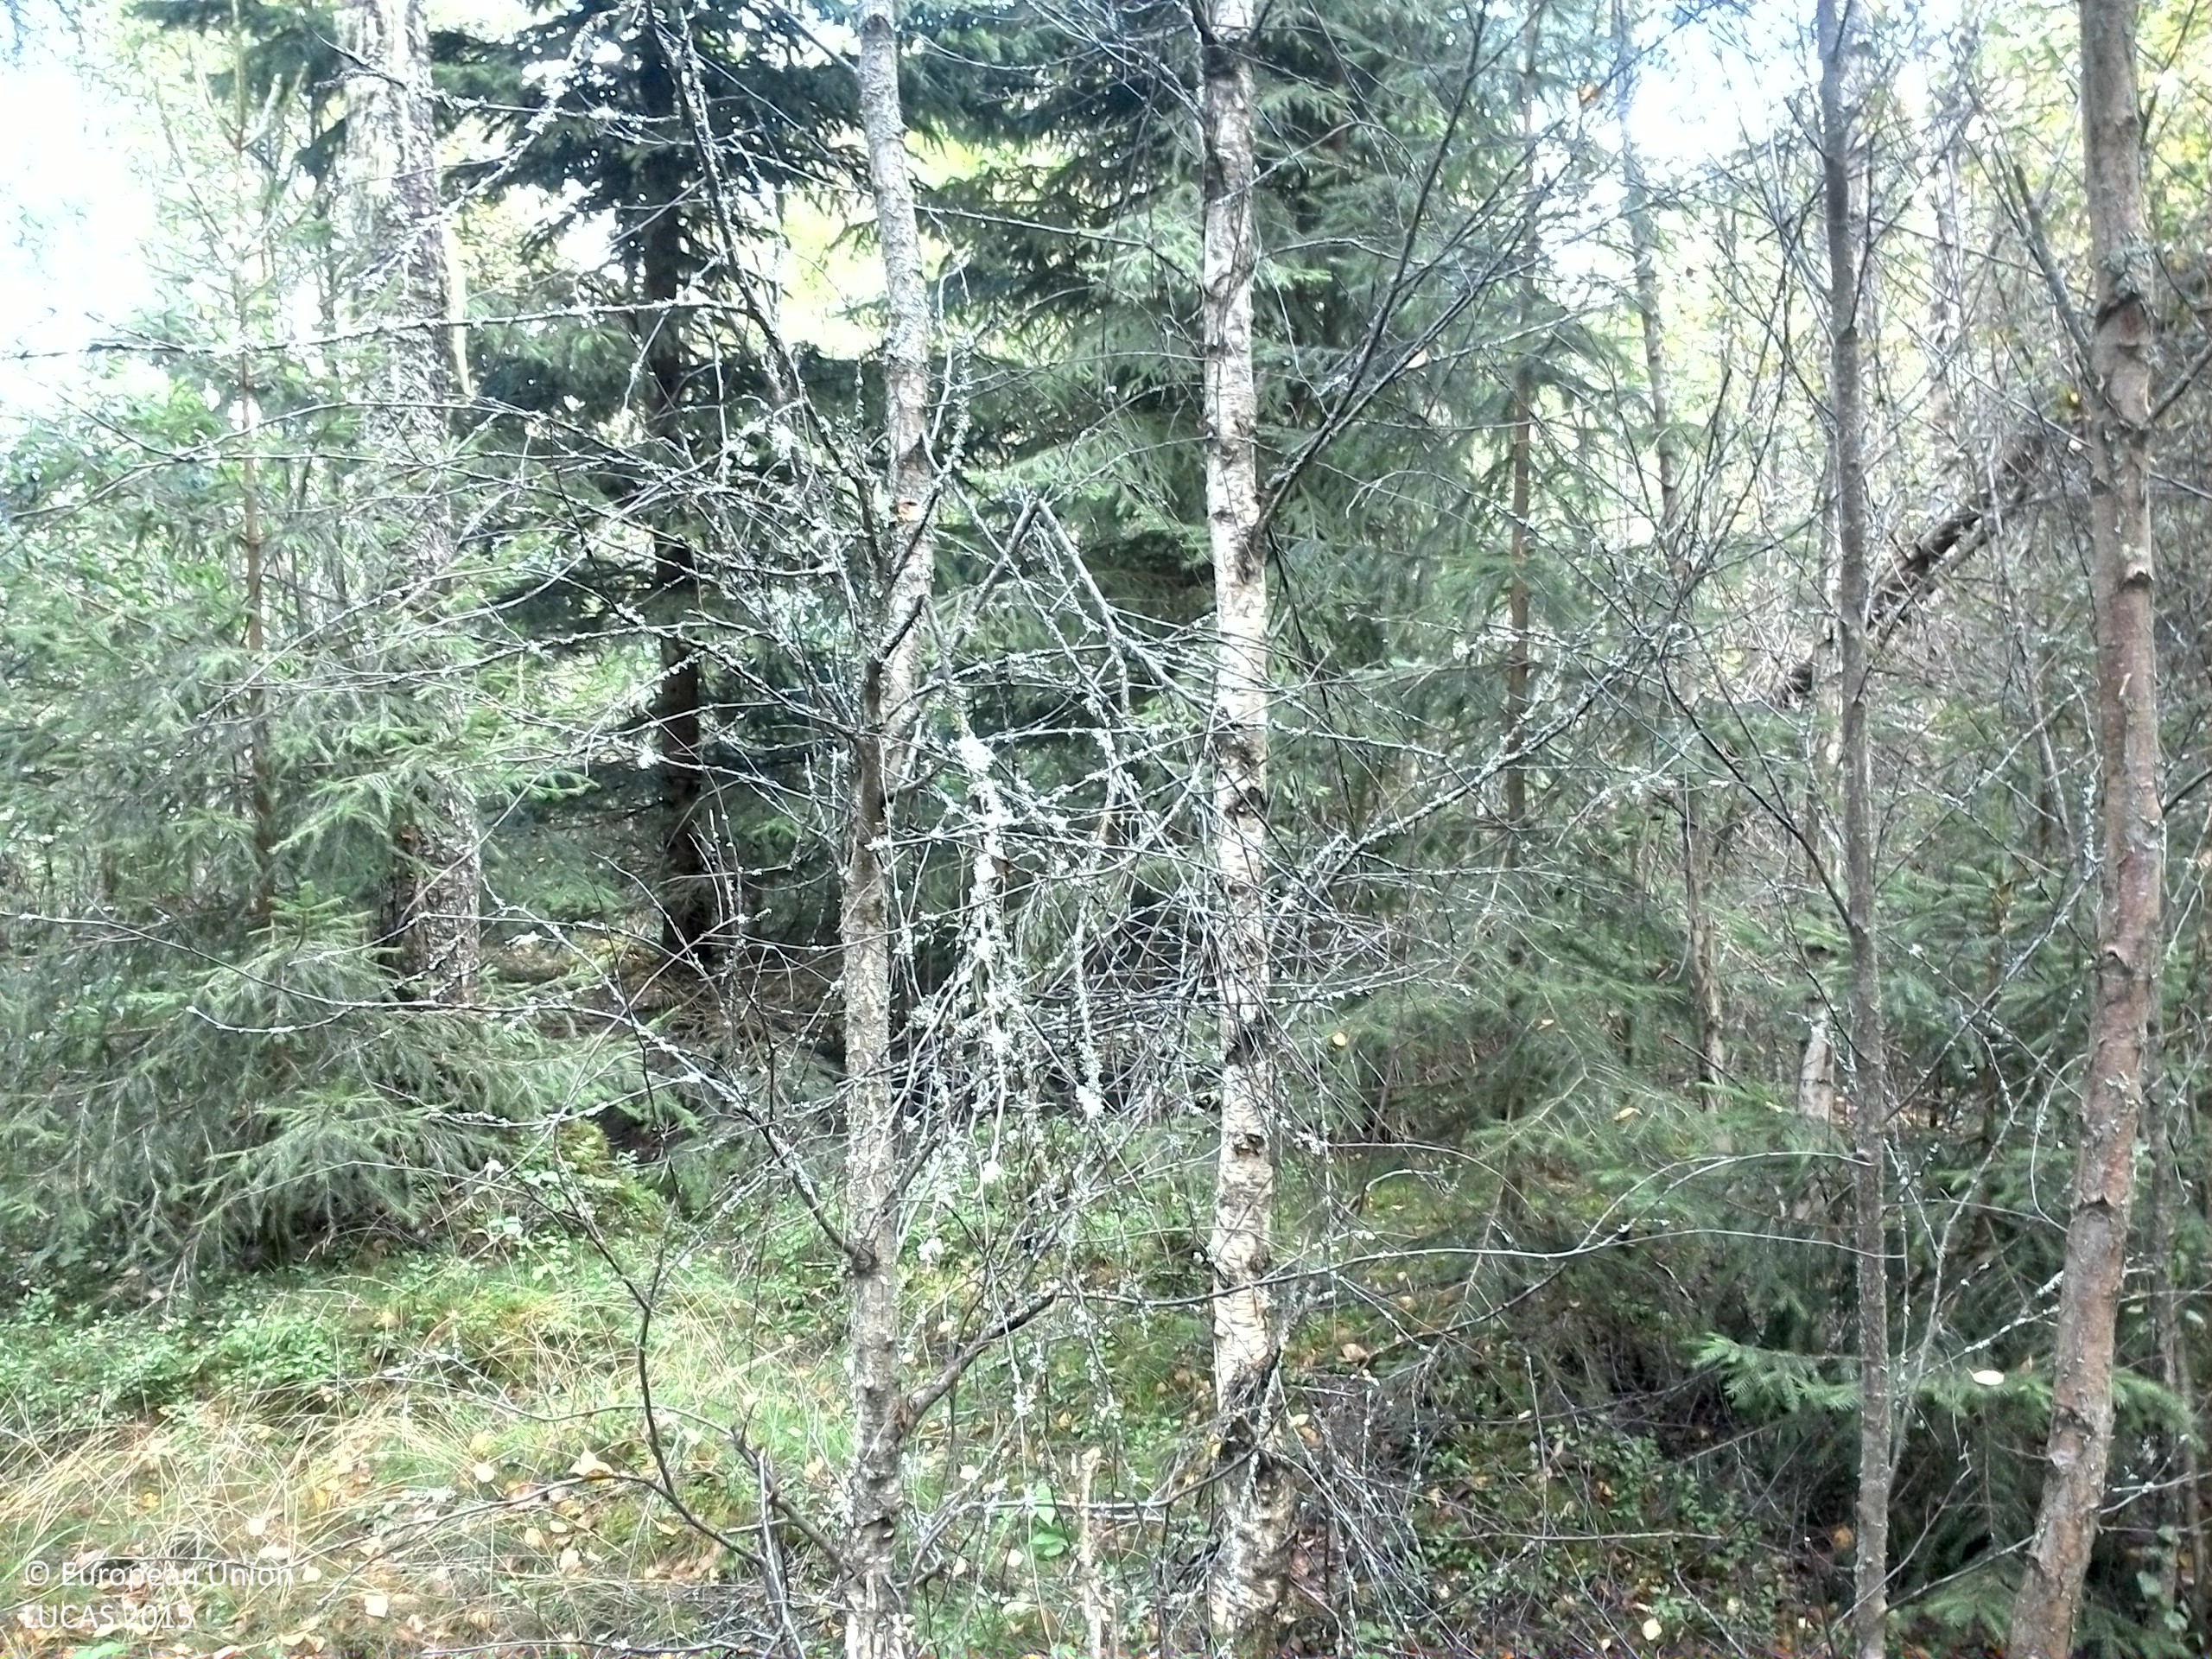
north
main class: Woodland
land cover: Spruce dominated mixed woodland
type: boreal forest
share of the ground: 50 - 75 %
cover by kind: coniferous forest trees 45 %, broadleaved forest trees 30 %, herbaceous plants 15 %, lichens and mosses 10 %
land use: Forestry
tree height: > 5 m
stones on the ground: < 10 %
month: September
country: SE
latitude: 59.7665
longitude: 13.1789
